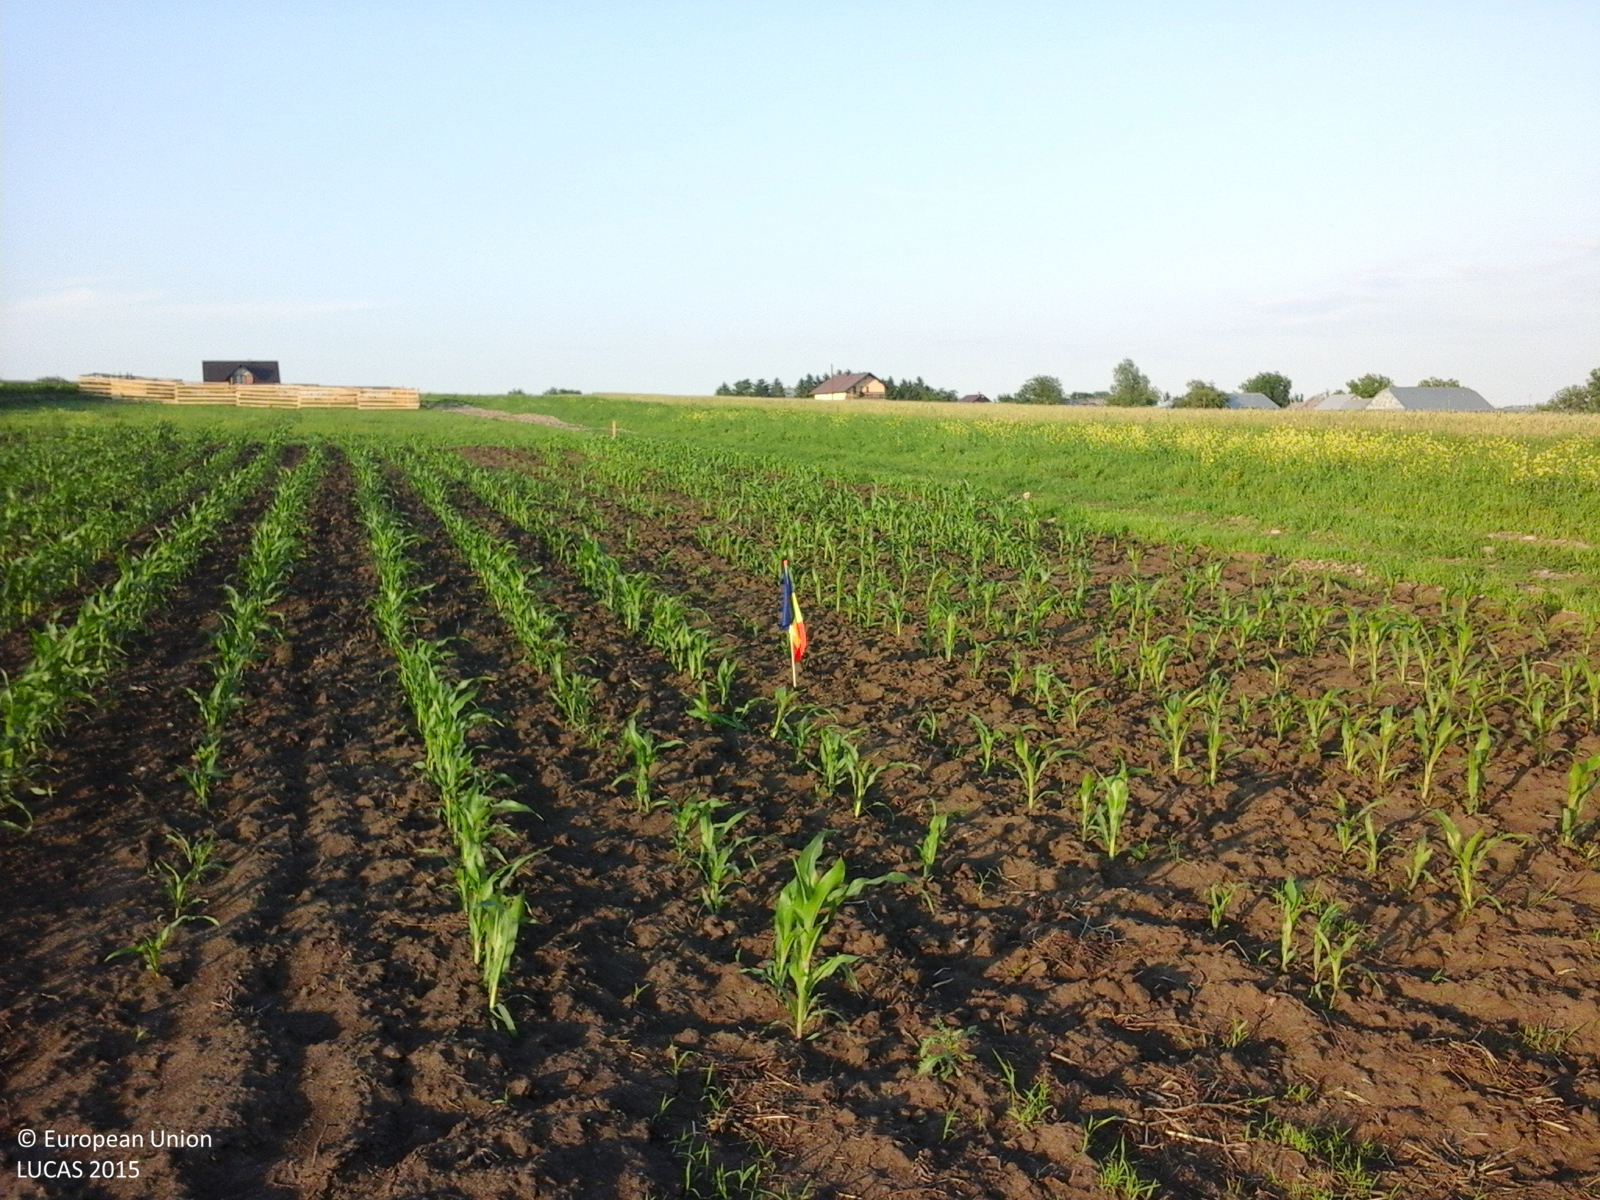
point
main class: Cropland
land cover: Maize
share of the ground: 25 - 50 %
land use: Agriculture (excluding fallow land and kitchen gardens)
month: June
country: RO
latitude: 47.5997
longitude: 26.2151
